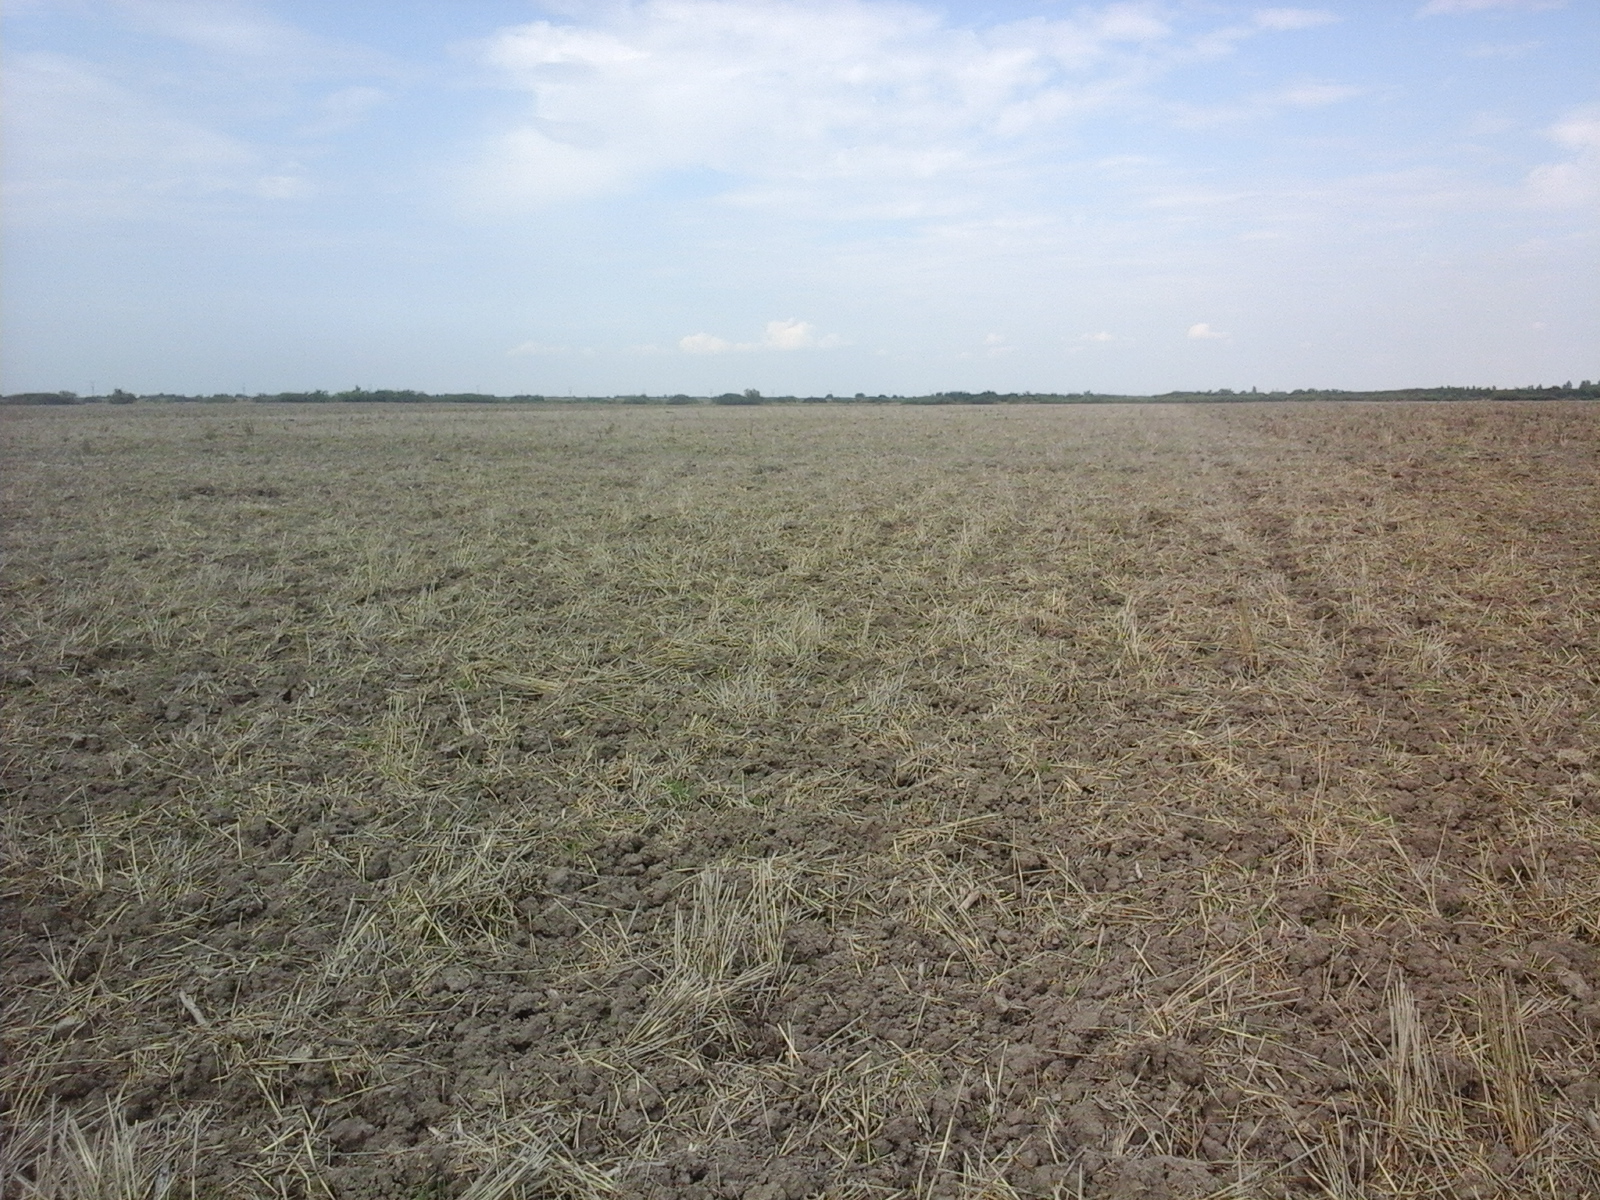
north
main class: Cropland
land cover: Common wheat
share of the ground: < 10 %
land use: Agriculture (excluding fallow land and kitchen gardens)
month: August
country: RO
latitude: 46.7431
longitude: 21.7036
